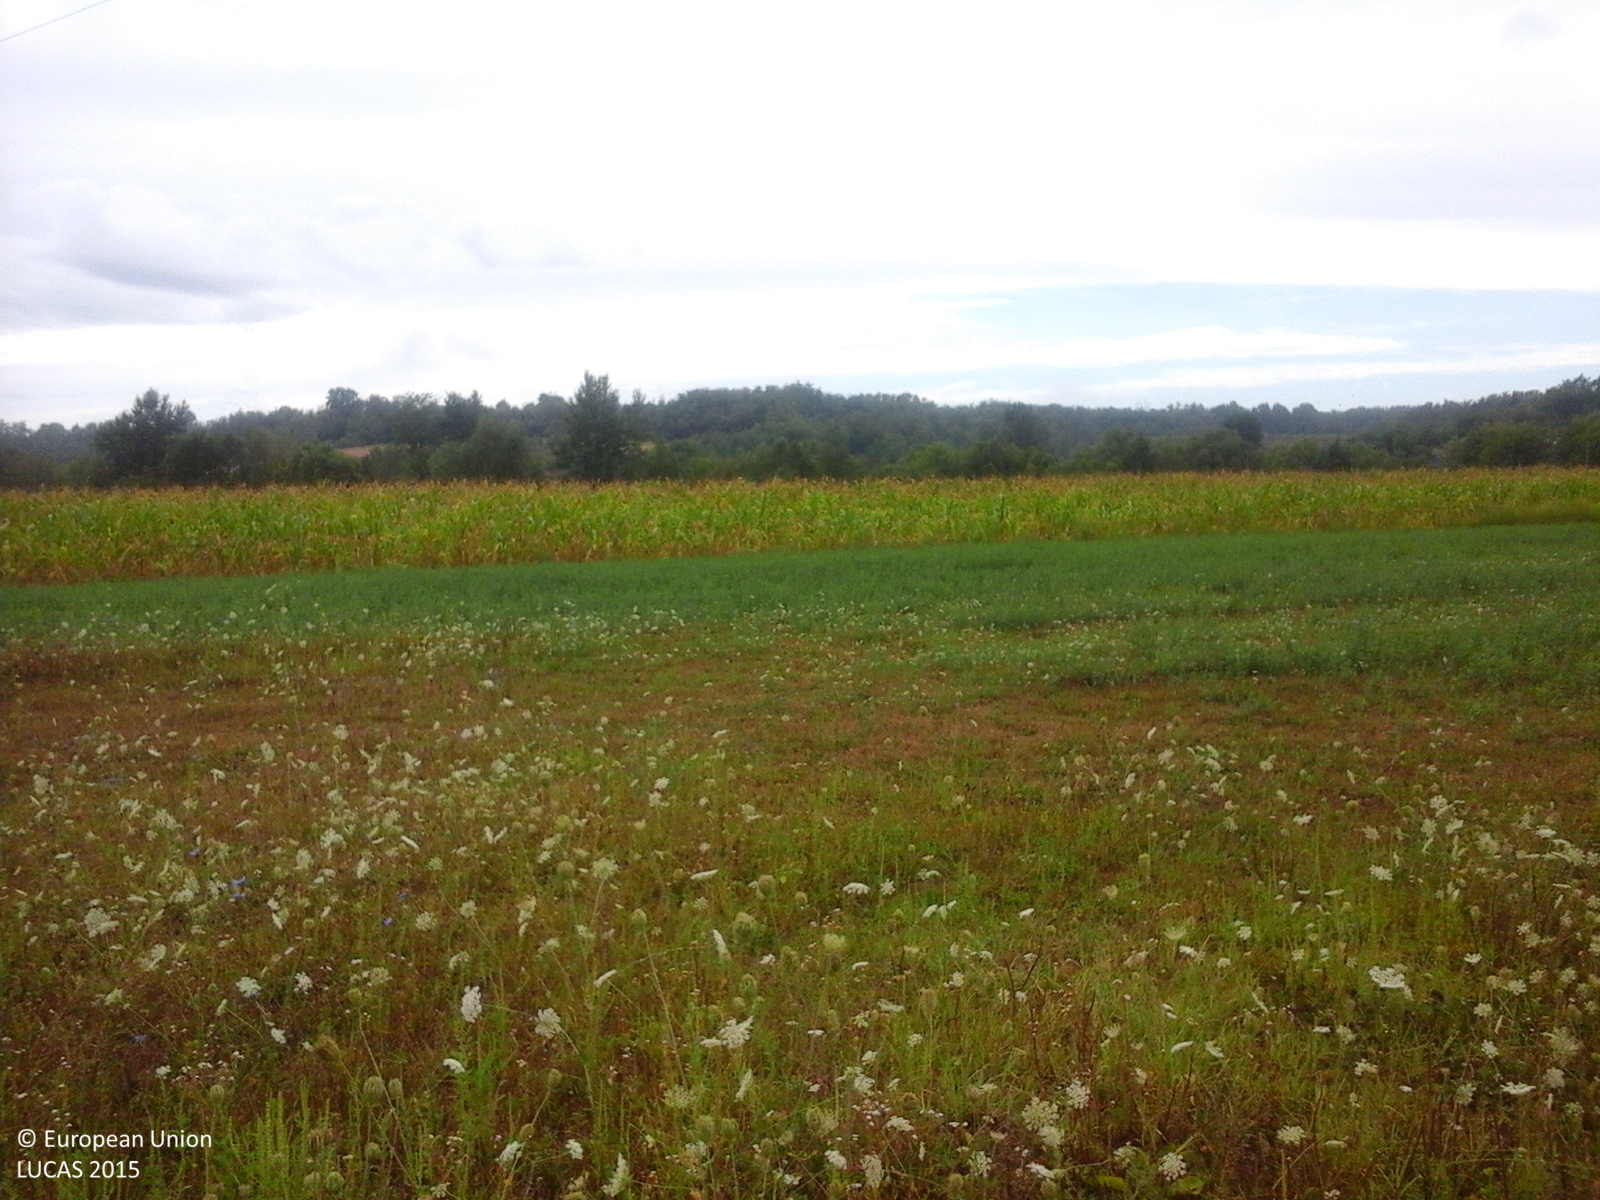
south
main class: Cropland
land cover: Lucerne
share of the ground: > 75 %
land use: Agriculture (excluding fallow land and kitchen gardens)
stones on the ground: < 10 %
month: August
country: RO
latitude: 44.7291
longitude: 22.8867
